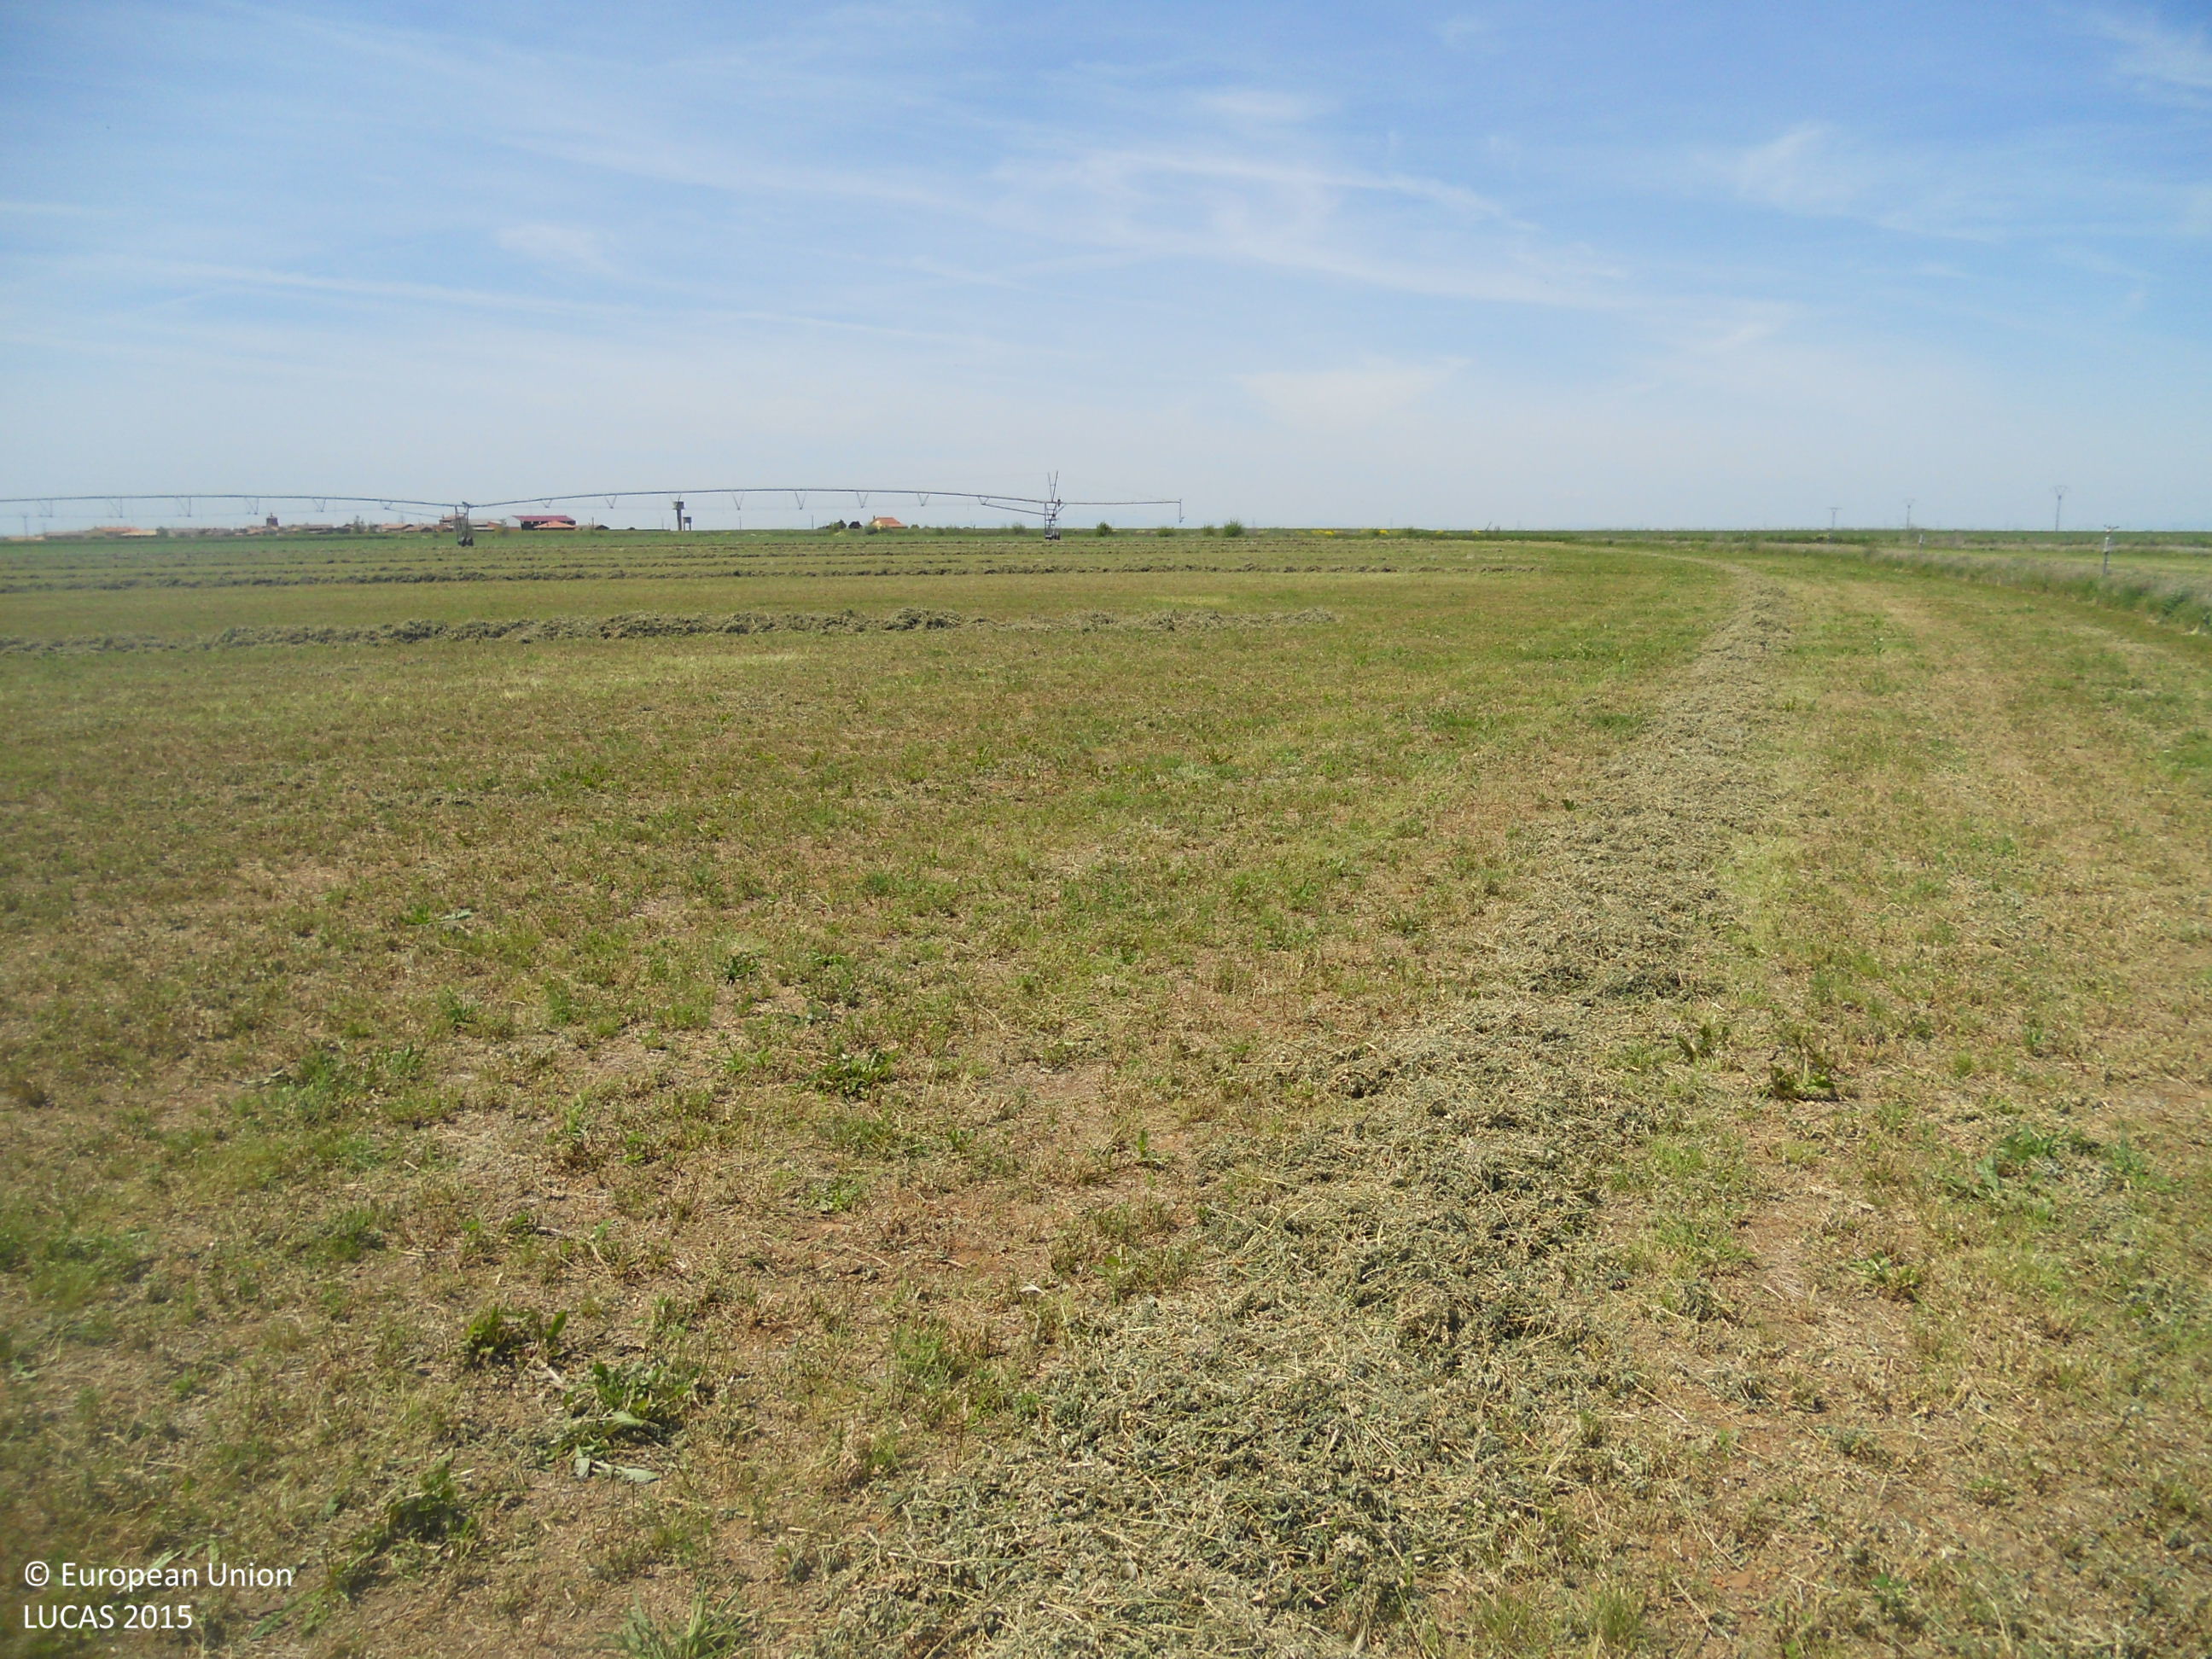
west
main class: Cropland
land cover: Lucerne
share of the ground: > 75 %
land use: Agriculture (excluding fallow land and kitchen gardens)
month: May
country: ES
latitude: 42.4028
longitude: -5.2883
